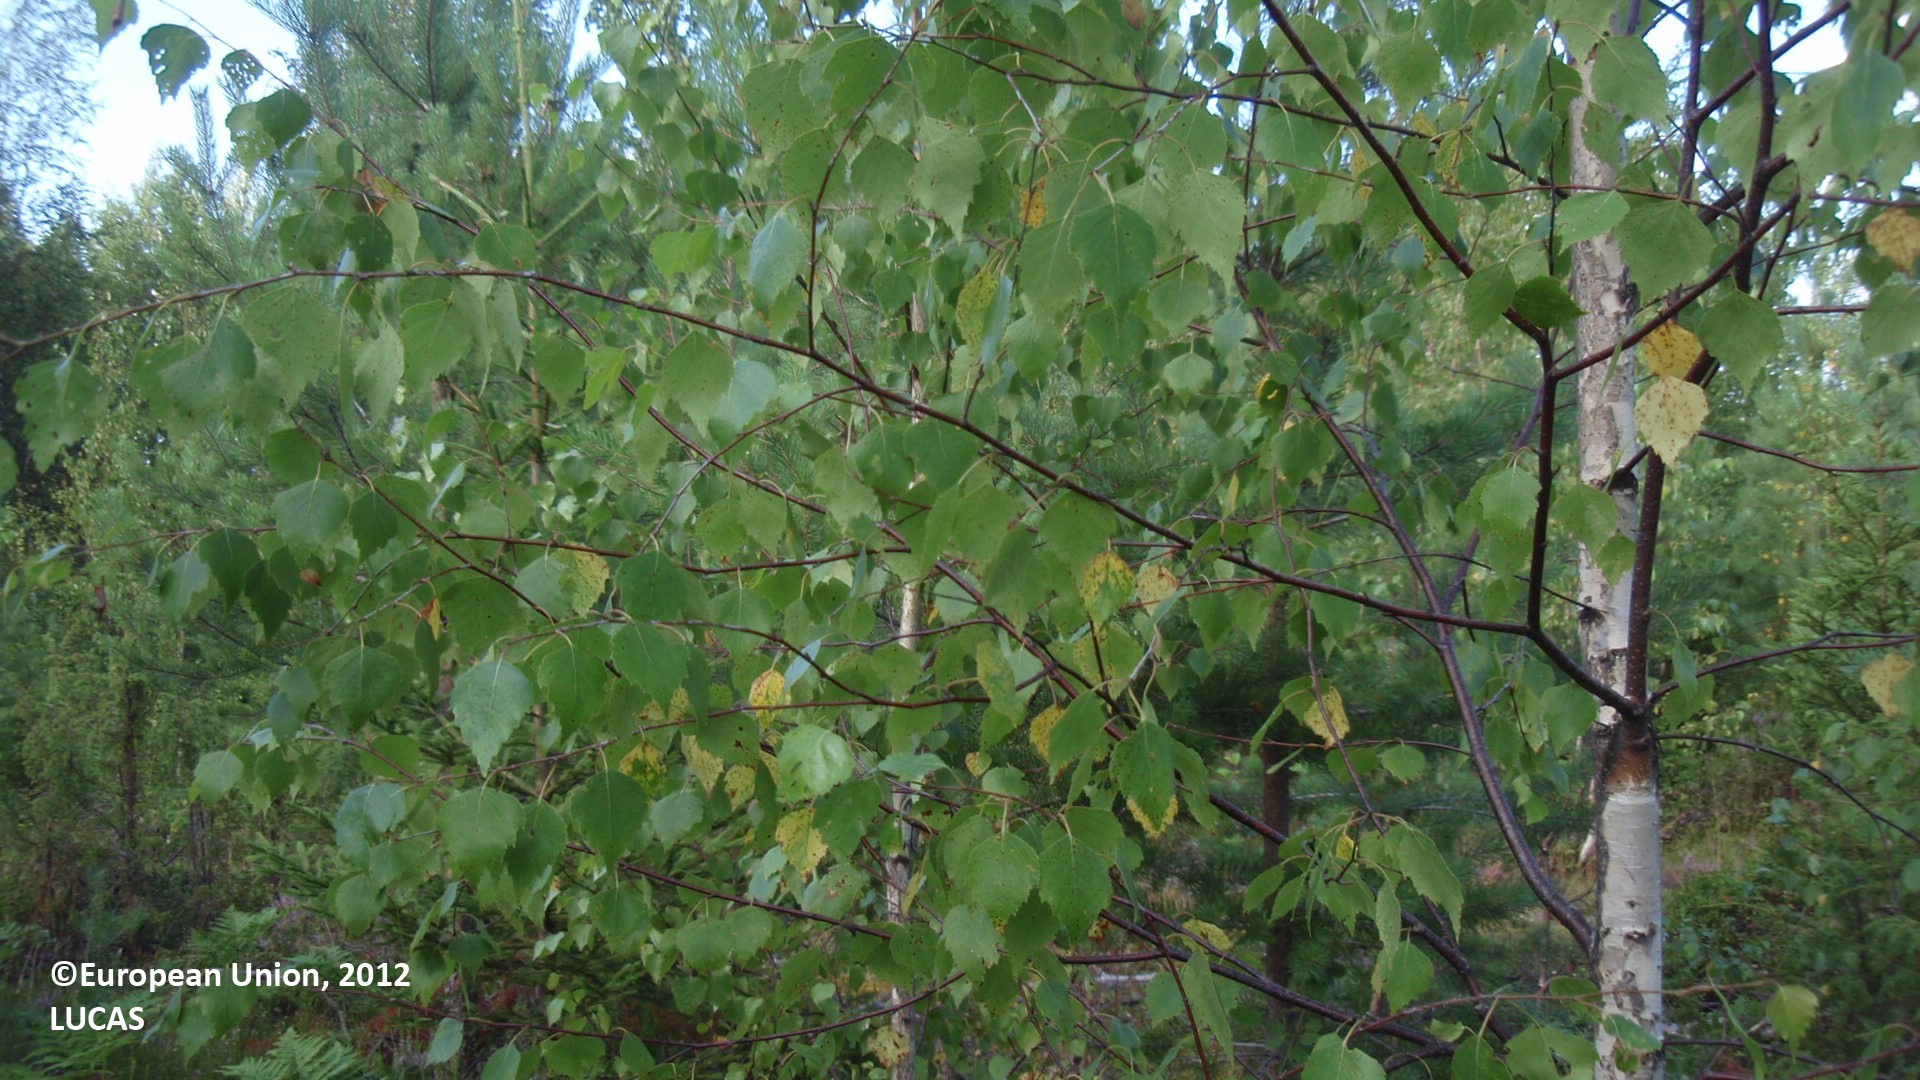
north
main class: Woodland
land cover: Pine dominated mixed woodland
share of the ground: 25 - 50 %
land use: Forestry
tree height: < 5 m
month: July
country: FI
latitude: 61.1605
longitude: 28.1364
